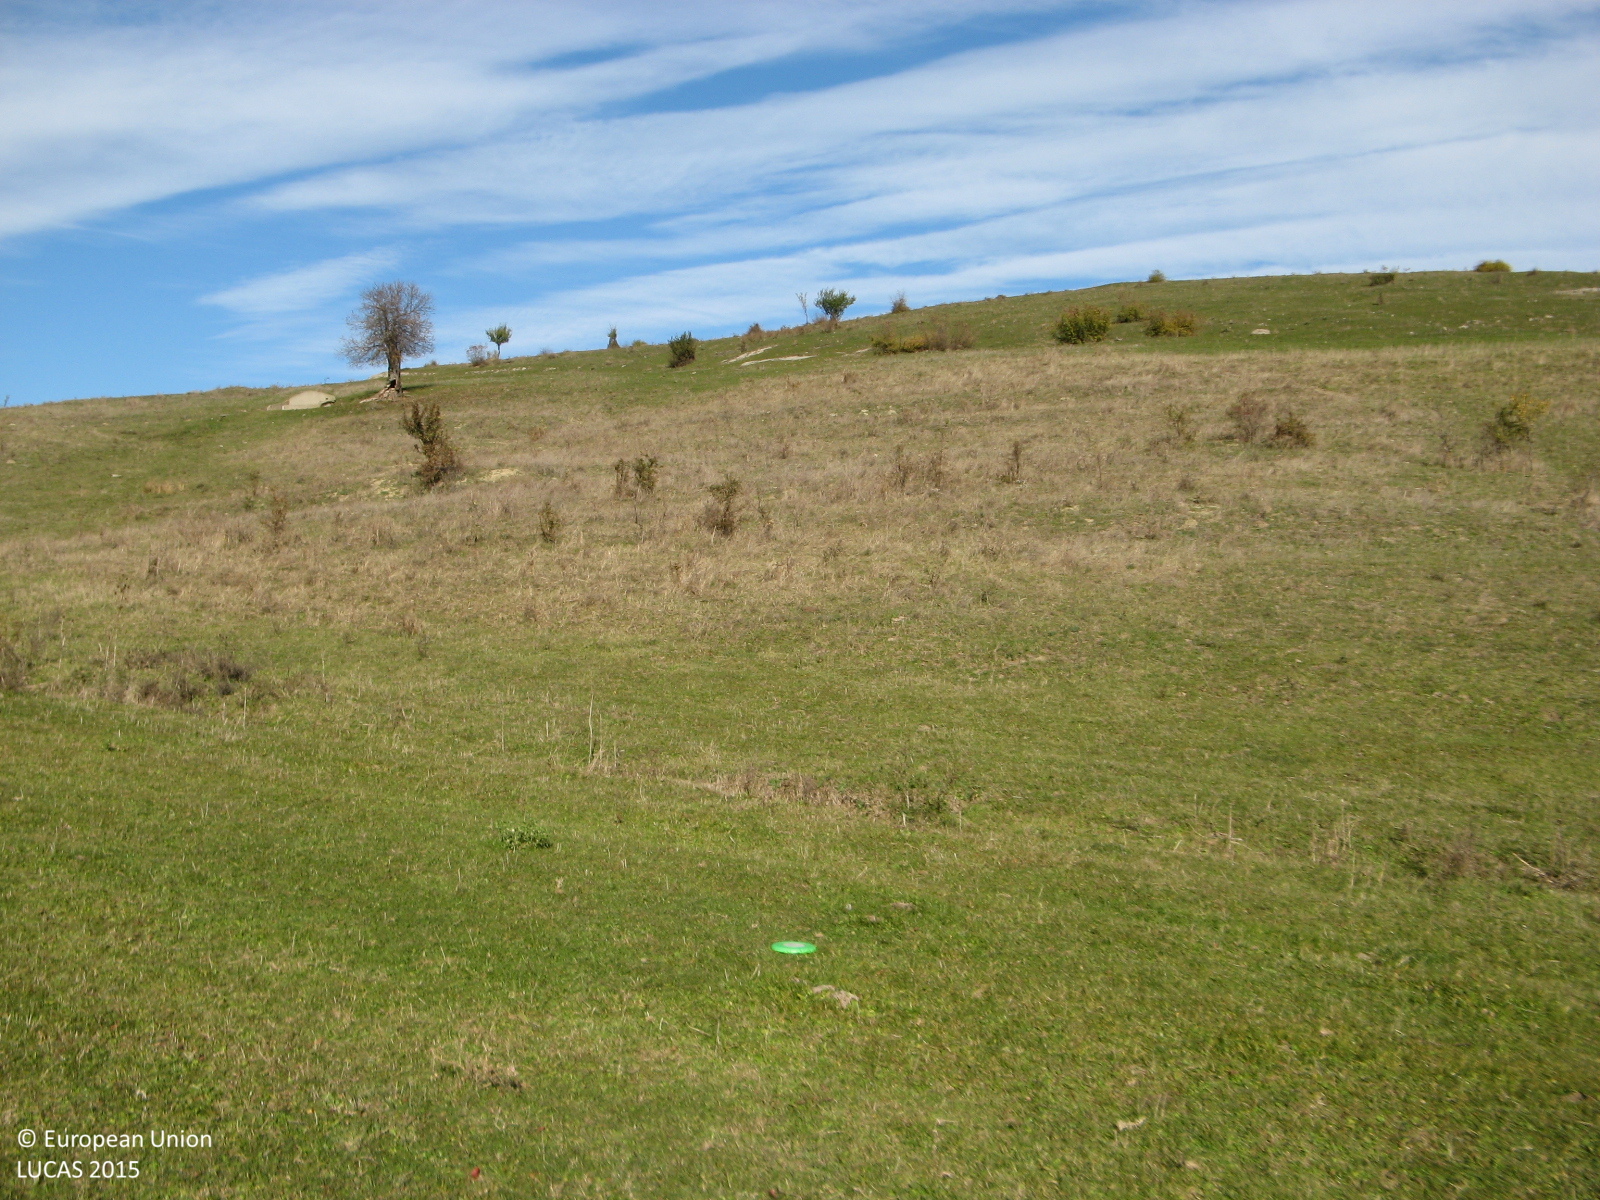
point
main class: Grassland
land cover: Grassland without tree/shrub cover
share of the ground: > 75 %
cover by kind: herbaceous plants 100 %
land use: Agriculture (excluding fallow land and kitchen gardens)
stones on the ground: < 10 %
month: November
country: BG
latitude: 41.7626
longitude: 25.3948
